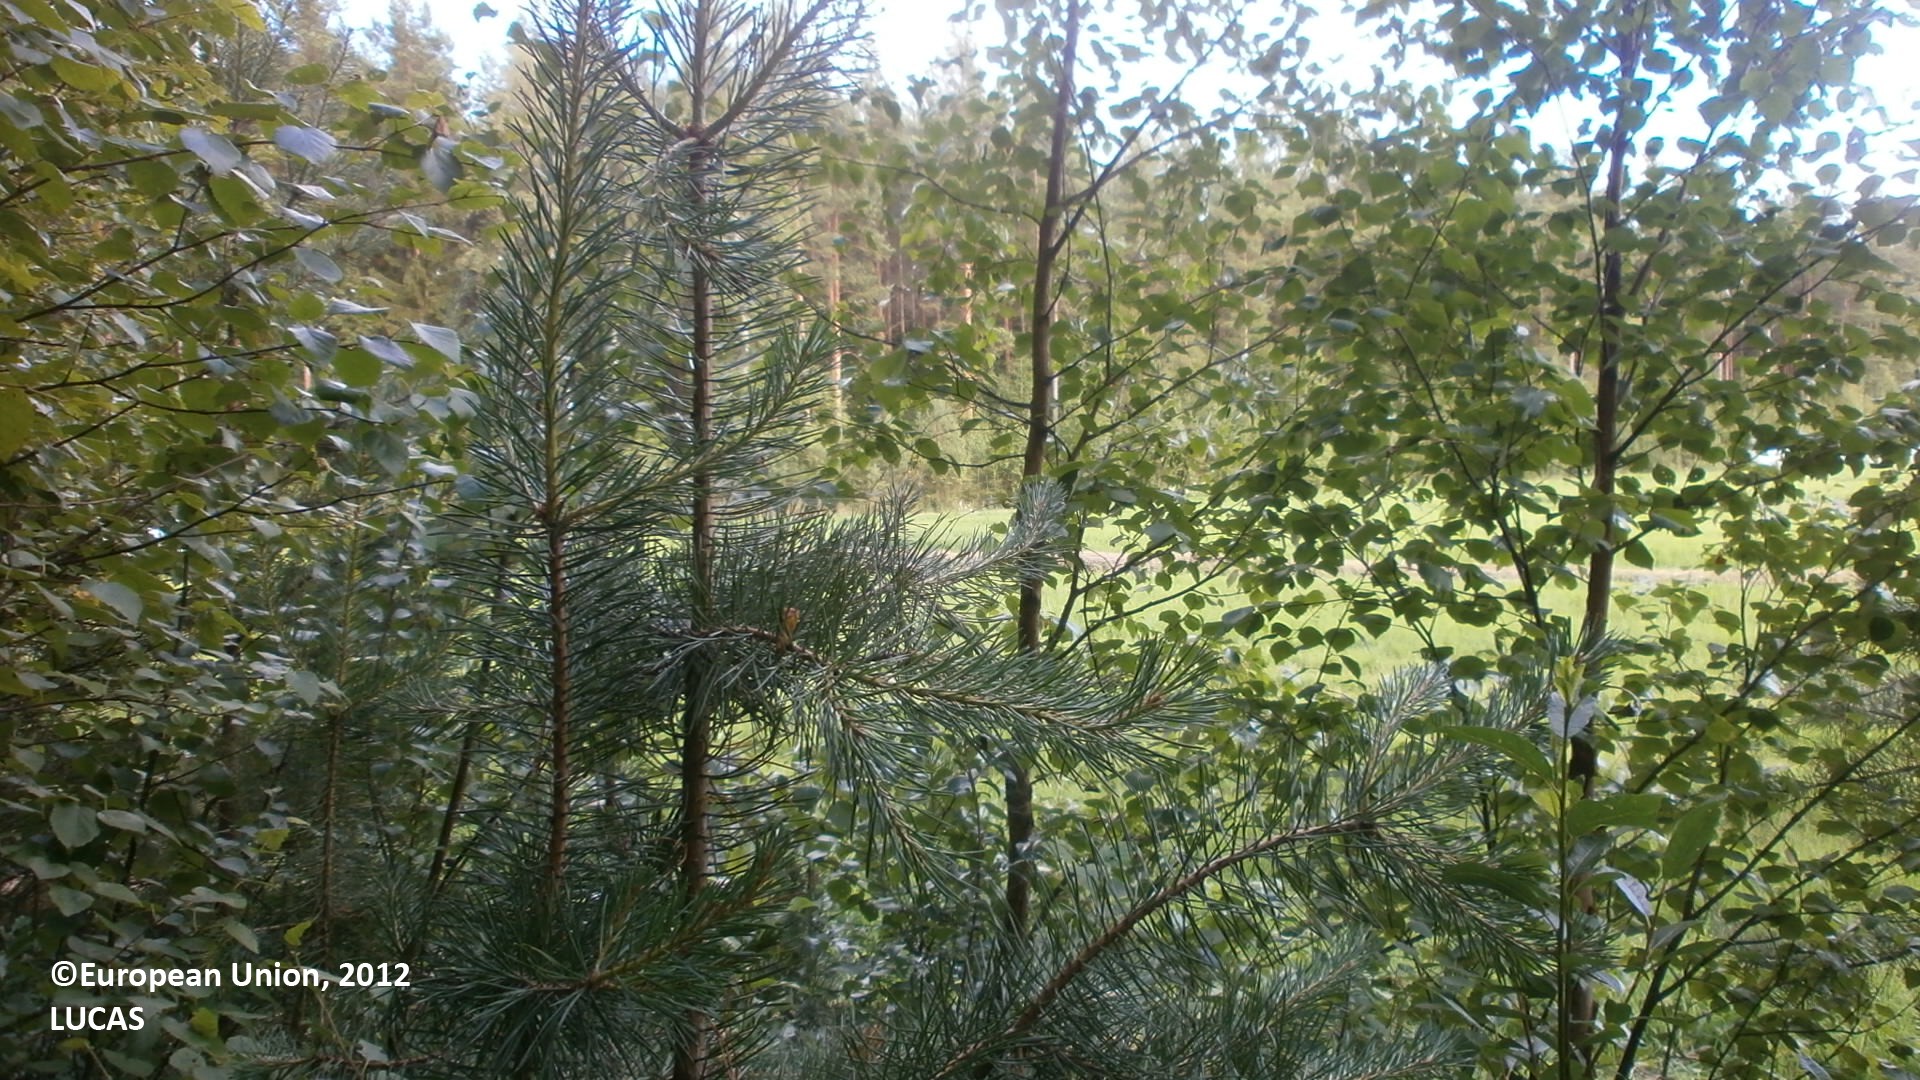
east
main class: Woodland
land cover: Spruce dominated mixed woodland
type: boreal forest
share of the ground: > 75 %
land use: Forestry
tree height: > 5 m
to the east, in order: Spruce dominated mixed woodland; Ditches and canals; Temporary grasslands; Grass margins; Ditches and canals; Pine dominated coniferous woodland; Ditches and canals; Pine dominated coniferous woodland; Ditches and canals; Pine dominated coniferous woodland
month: July
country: FI
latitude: 63.9780
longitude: 23.9779
